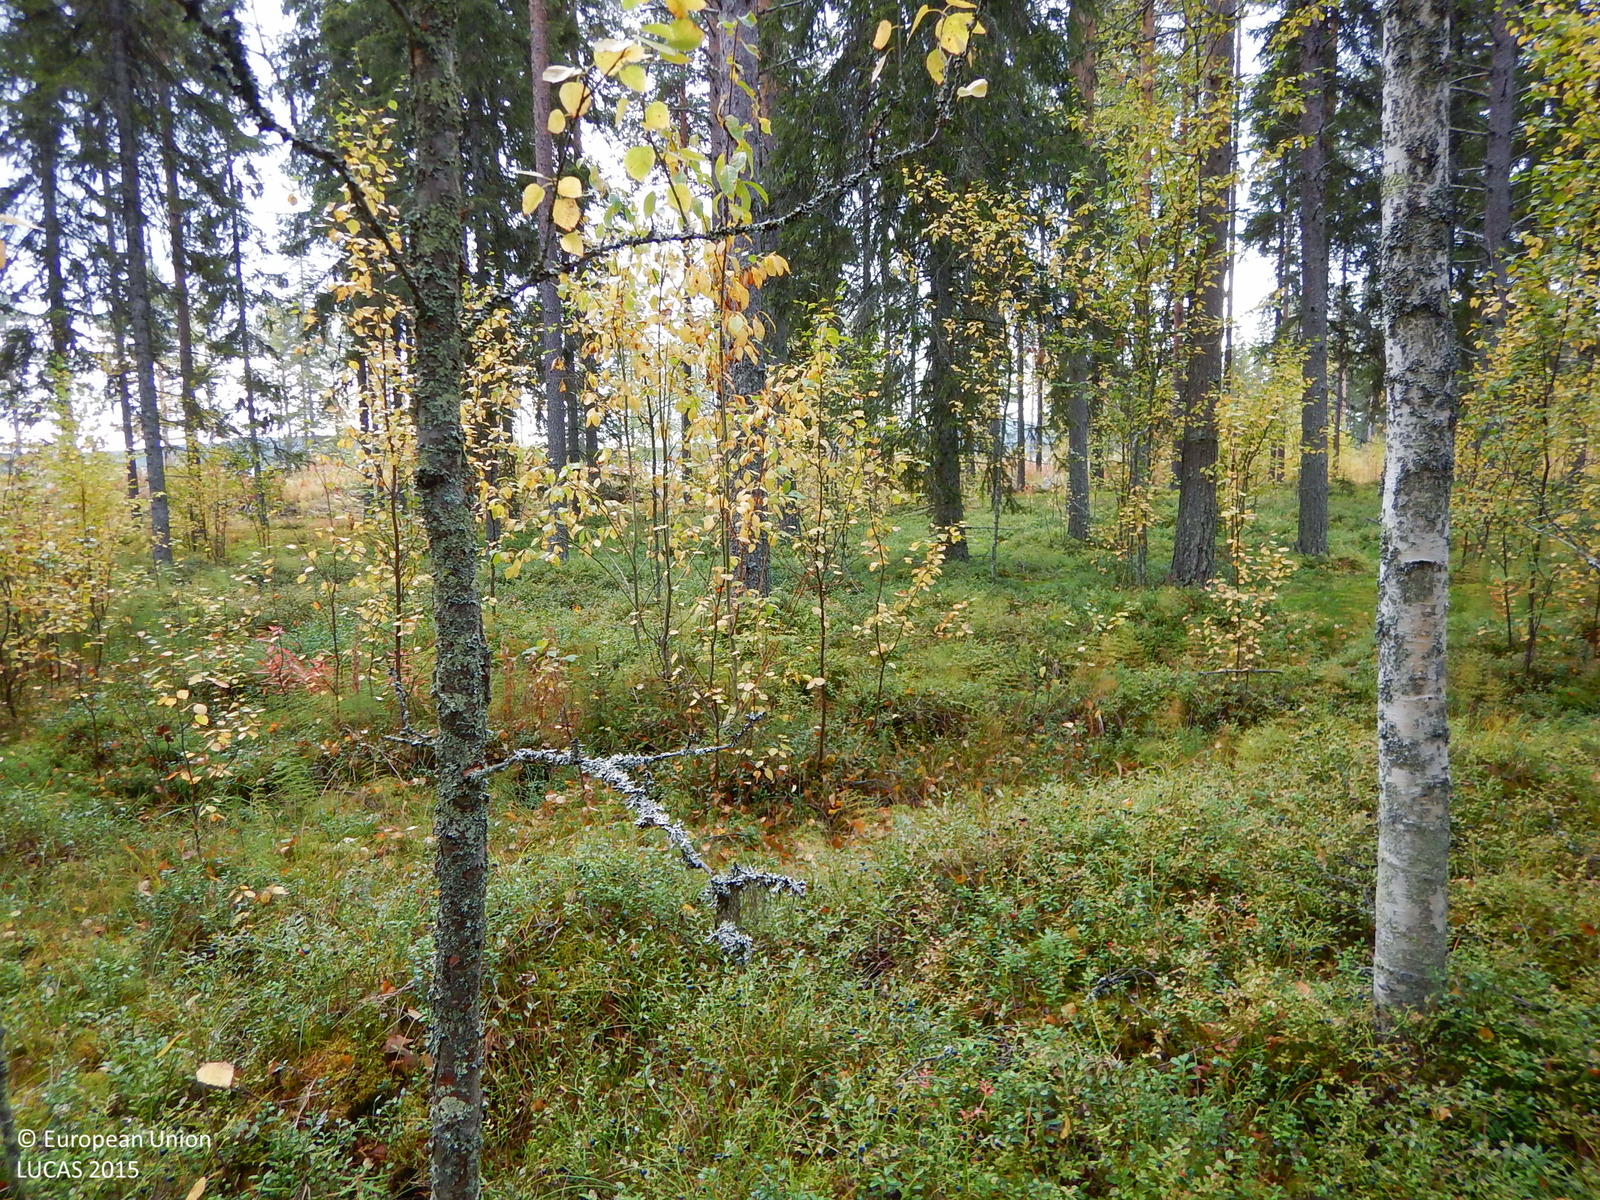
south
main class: Woodland
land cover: Pine dominated mixed woodland
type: boreal forest
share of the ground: 50 - 75 %
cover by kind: coniferous forest trees 40 %, shrubs 20 %, broadleaved forest trees 15 %, lichens and mosses 15 %, herbaceous plants 10 %
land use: Forestry
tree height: > 5 m
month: September
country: SE
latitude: 64.8384
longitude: 19.8564
